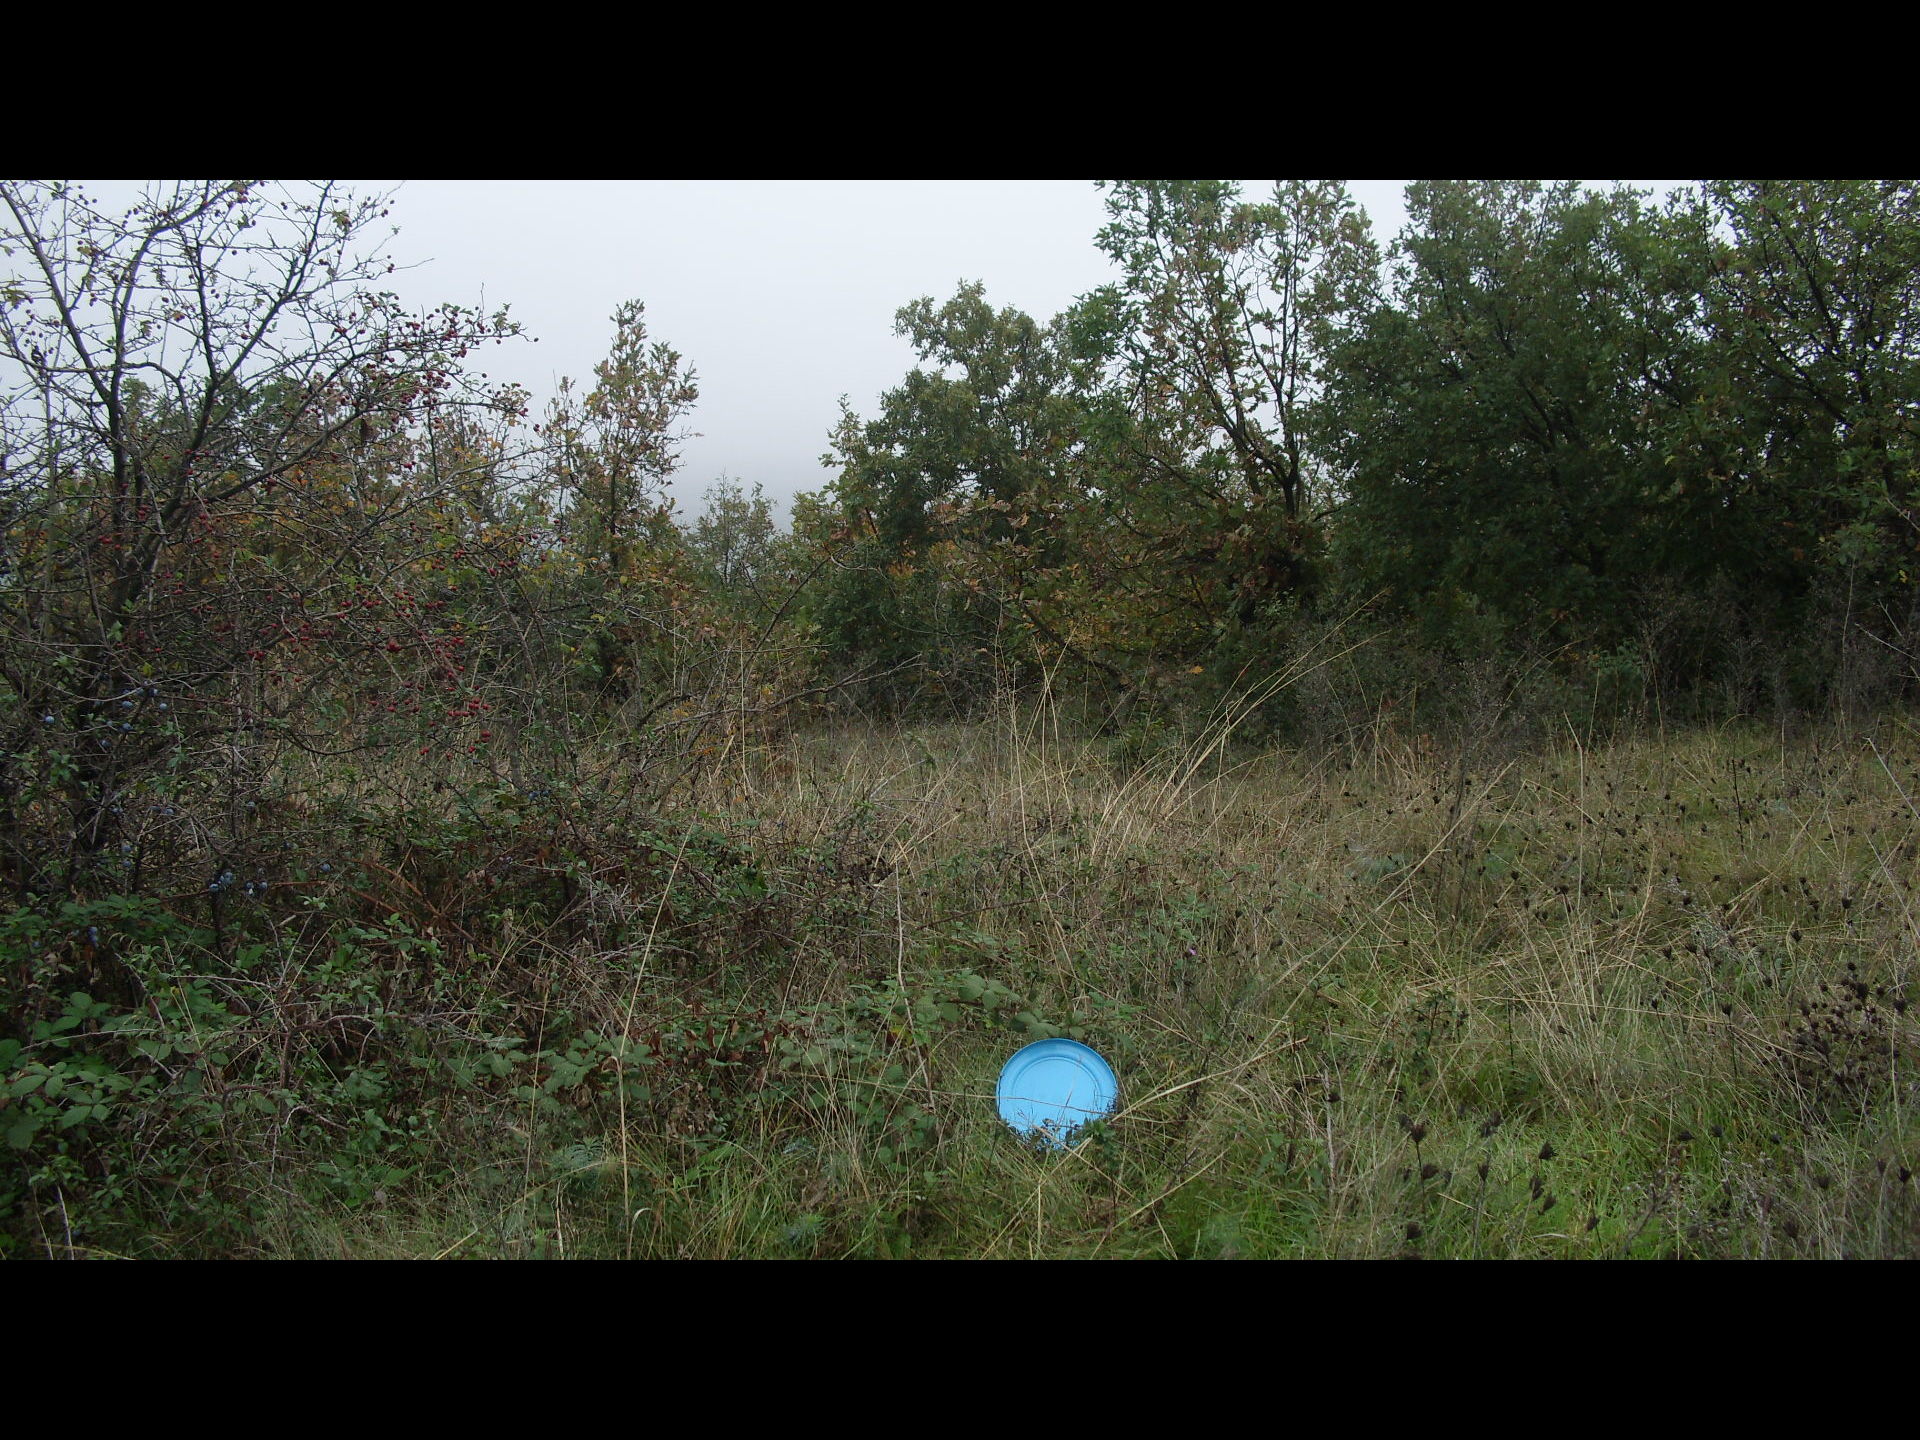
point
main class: Grassland
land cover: Grassland with sparse tree/shrub cover
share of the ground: > 75 %
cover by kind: herbaceous plants 90 %, broadleaved forest trees 5 %, shrubs 5 %
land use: Semi-natural and natural areas not in use
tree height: < 5 m
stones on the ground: < 10 %
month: October
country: BG
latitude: 43.5631
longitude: 22.8744
